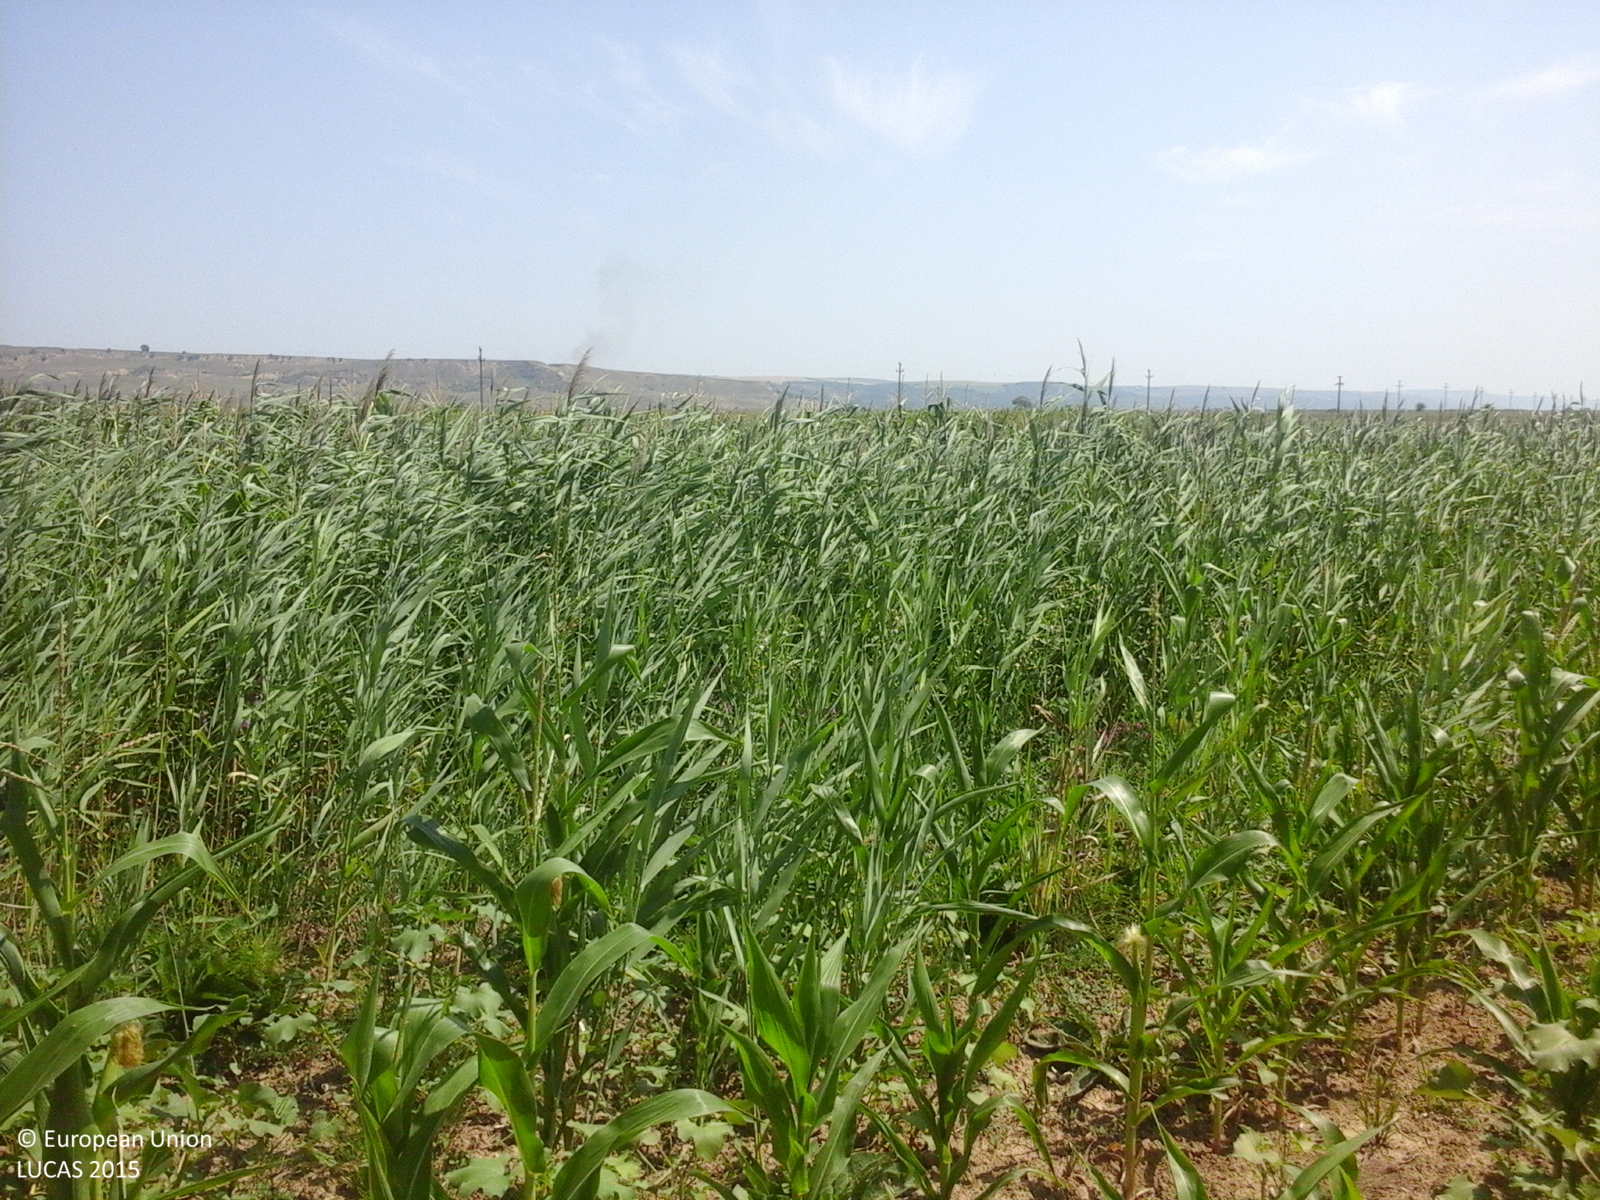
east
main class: Cropland
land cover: Maize
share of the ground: > 75 %
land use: Agriculture (excluding fallow land and kitchen gardens)
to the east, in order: Maize; Tracks; Inland marshes; Maize; Ditches and canals; Maize; Electric lines; Maize
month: August
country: RO
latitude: 46.2700
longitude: 27.0817
